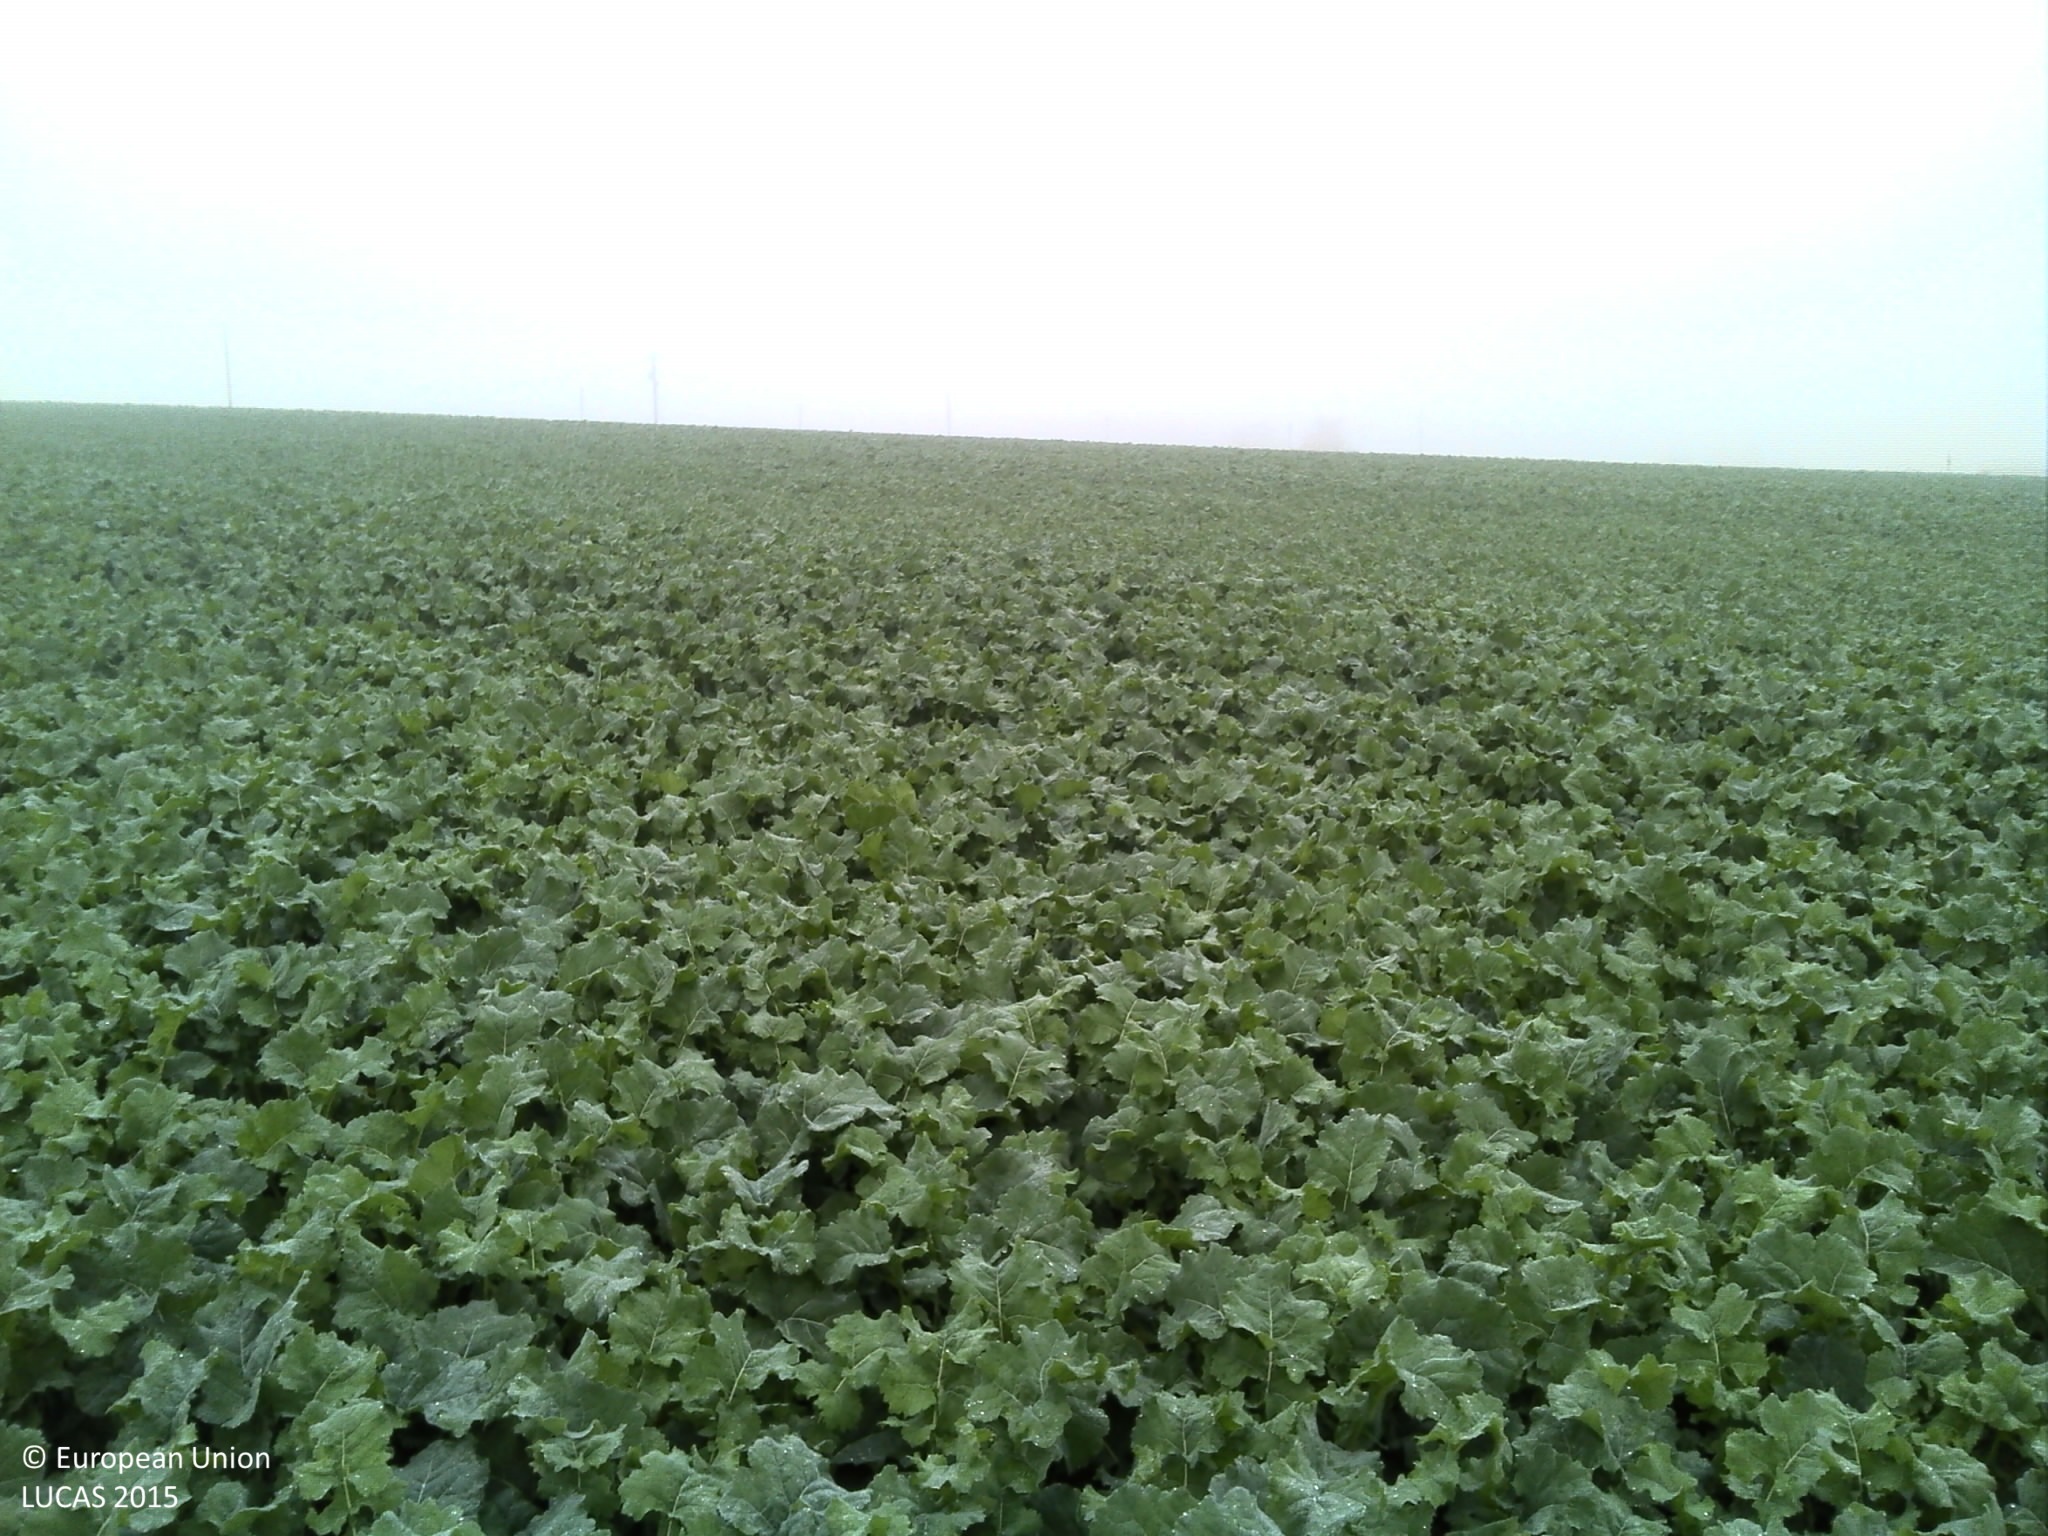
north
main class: Cropland
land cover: Rape and turnip rape
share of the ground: > 75 %
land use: Agriculture (excluding fallow land and kitchen gardens)
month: October
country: FR
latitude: 47.4369
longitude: 5.2670
